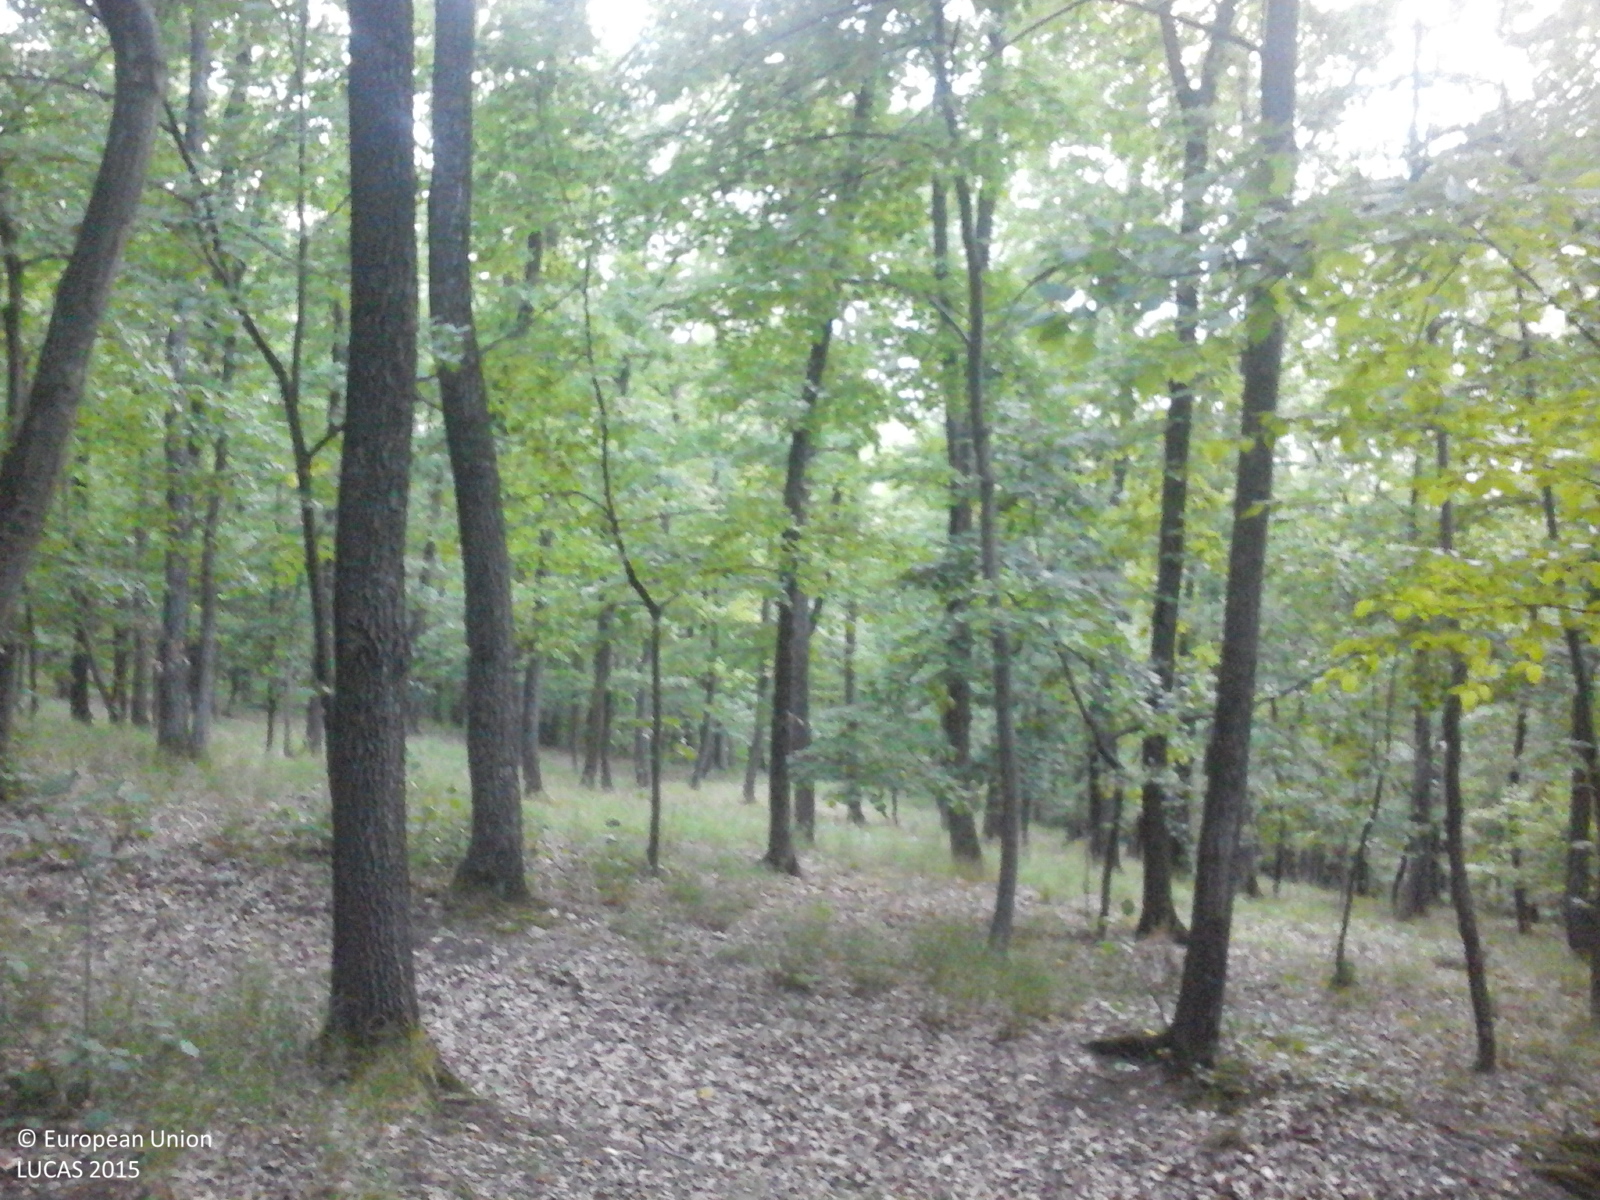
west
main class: Woodland
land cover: Broadleaved woodland
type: beech forest
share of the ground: > 75 %
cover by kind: broadleaved forest trees 100 %
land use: Forestry
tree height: > 5 m
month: June
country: RO
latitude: 47.1485
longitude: 26.9939
